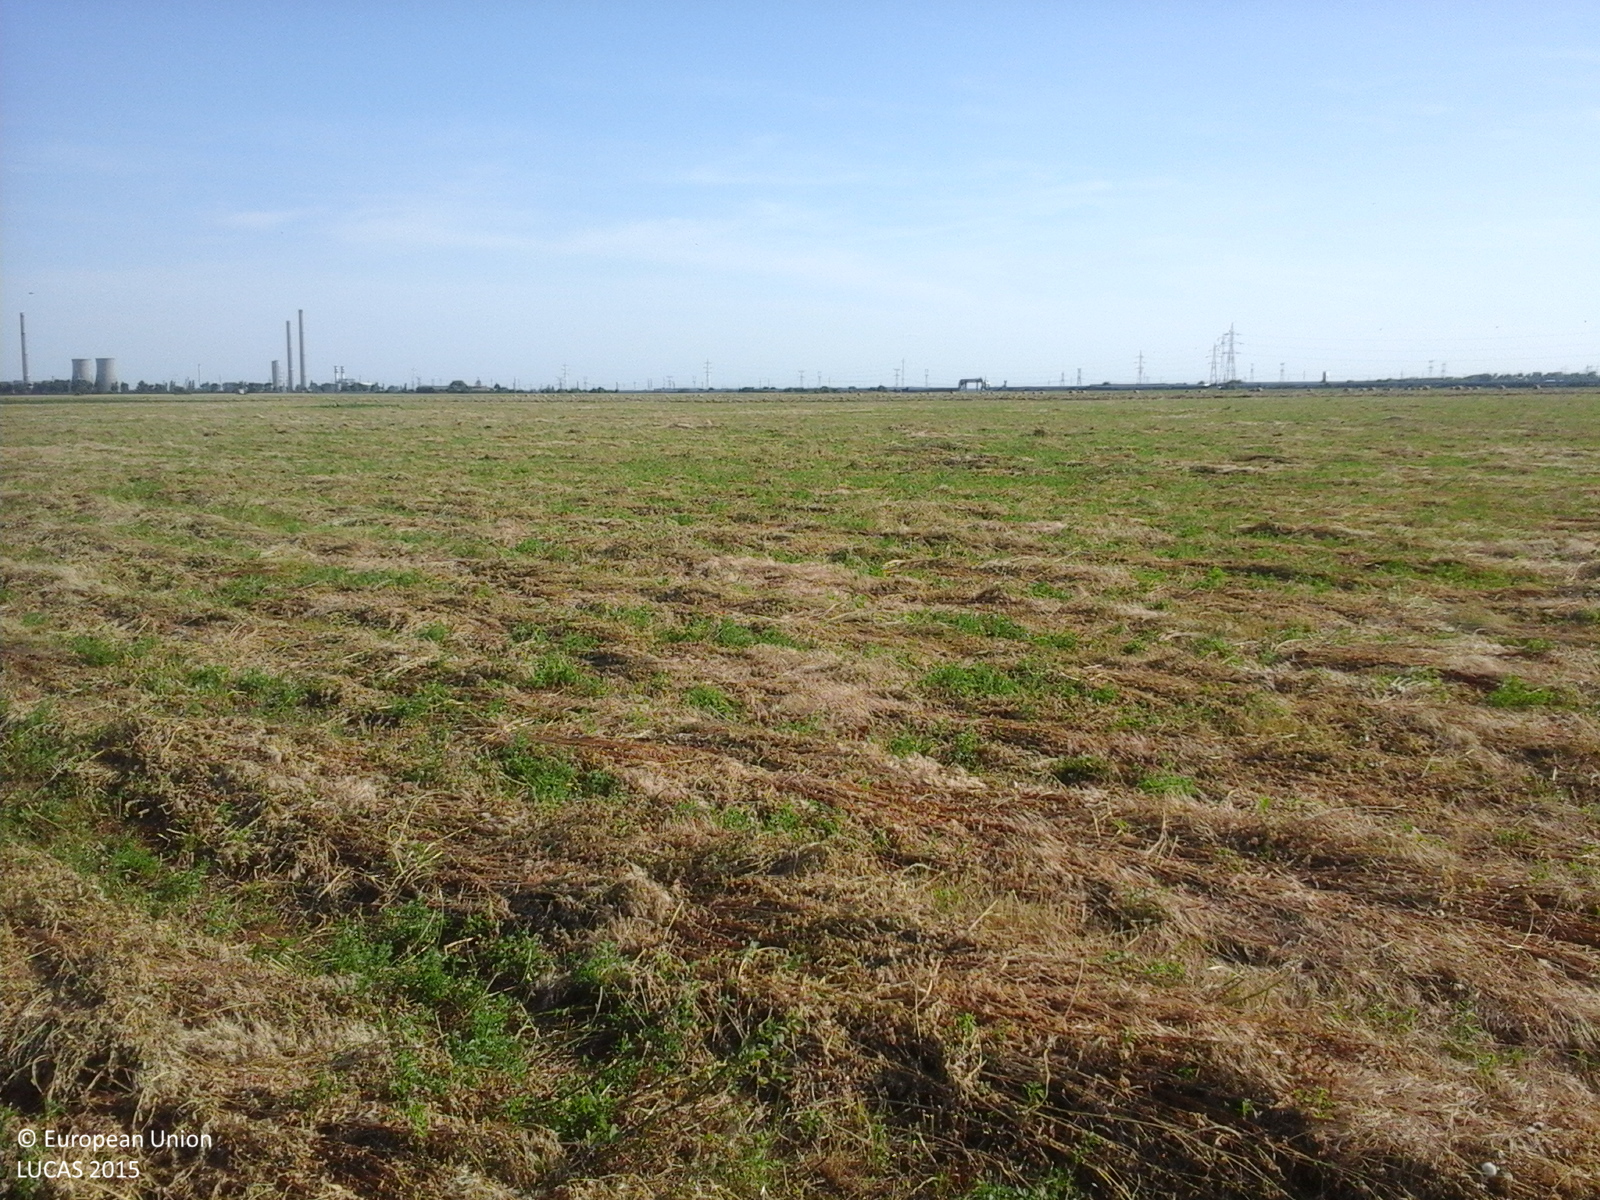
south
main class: Cropland
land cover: Lucerne
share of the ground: > 75 %
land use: Agriculture (excluding fallow land and kitchen gardens)
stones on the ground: < 10 %
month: June
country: RO
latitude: 44.9159
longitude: 26.0050
